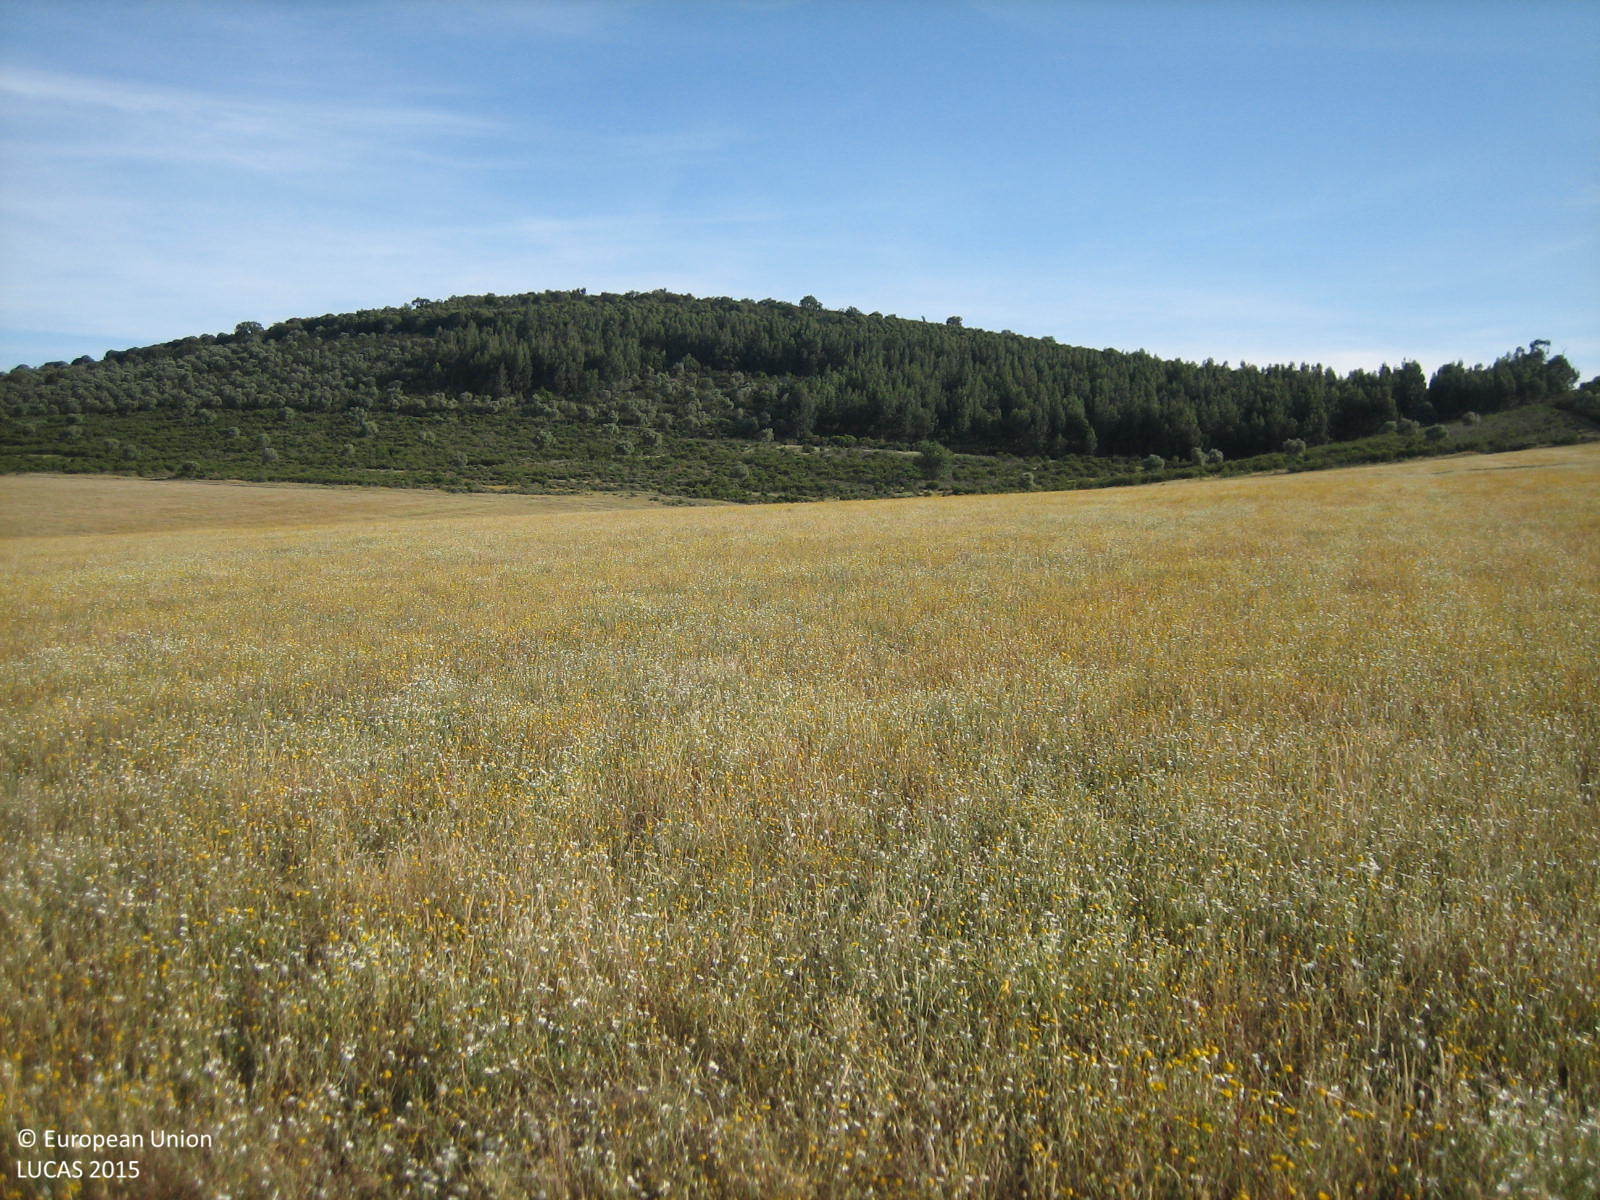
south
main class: Grassland
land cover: Spontaneously vegetated surfaces
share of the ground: > 75 %
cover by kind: herbaceous plants 100 %
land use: Agriculture (excluding fallow land and kitchen gardens)
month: May
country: ES
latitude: 39.0656
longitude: -4.7923
